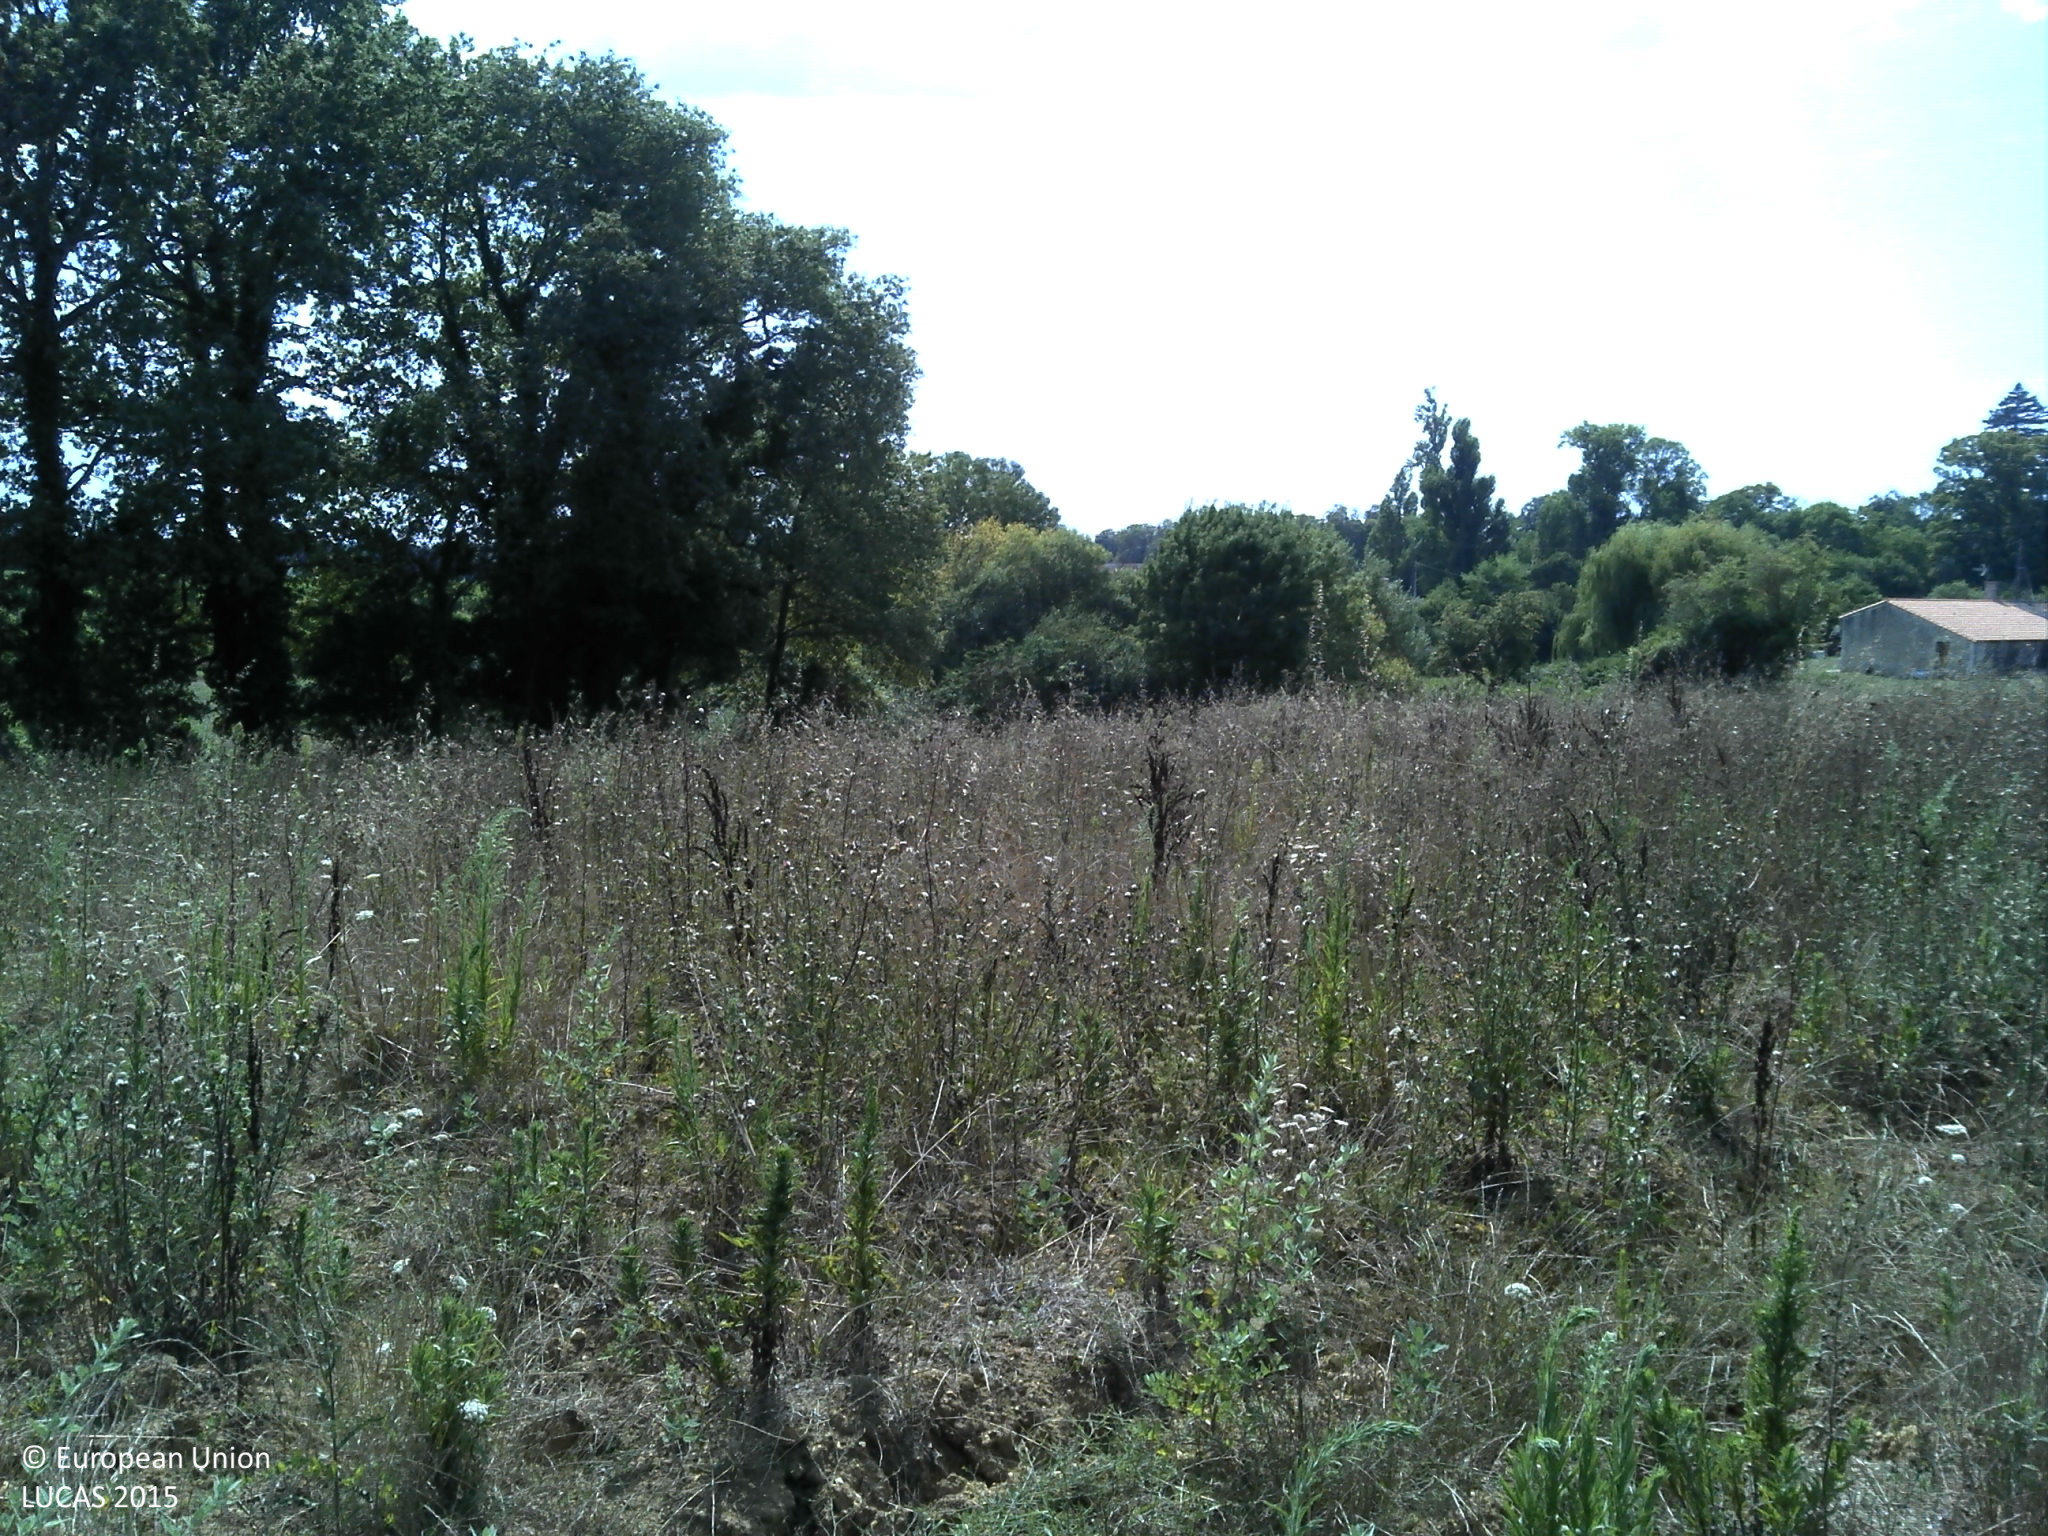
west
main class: Grassland
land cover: Spontaneously vegetated surfaces
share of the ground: 50 - 75 %
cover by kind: herbaceous plants 50 %, unconsolidated bare surface 50 %
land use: Semi-natural and natural areas not in use
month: August
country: FR
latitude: 45.2863
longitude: -0.8739
